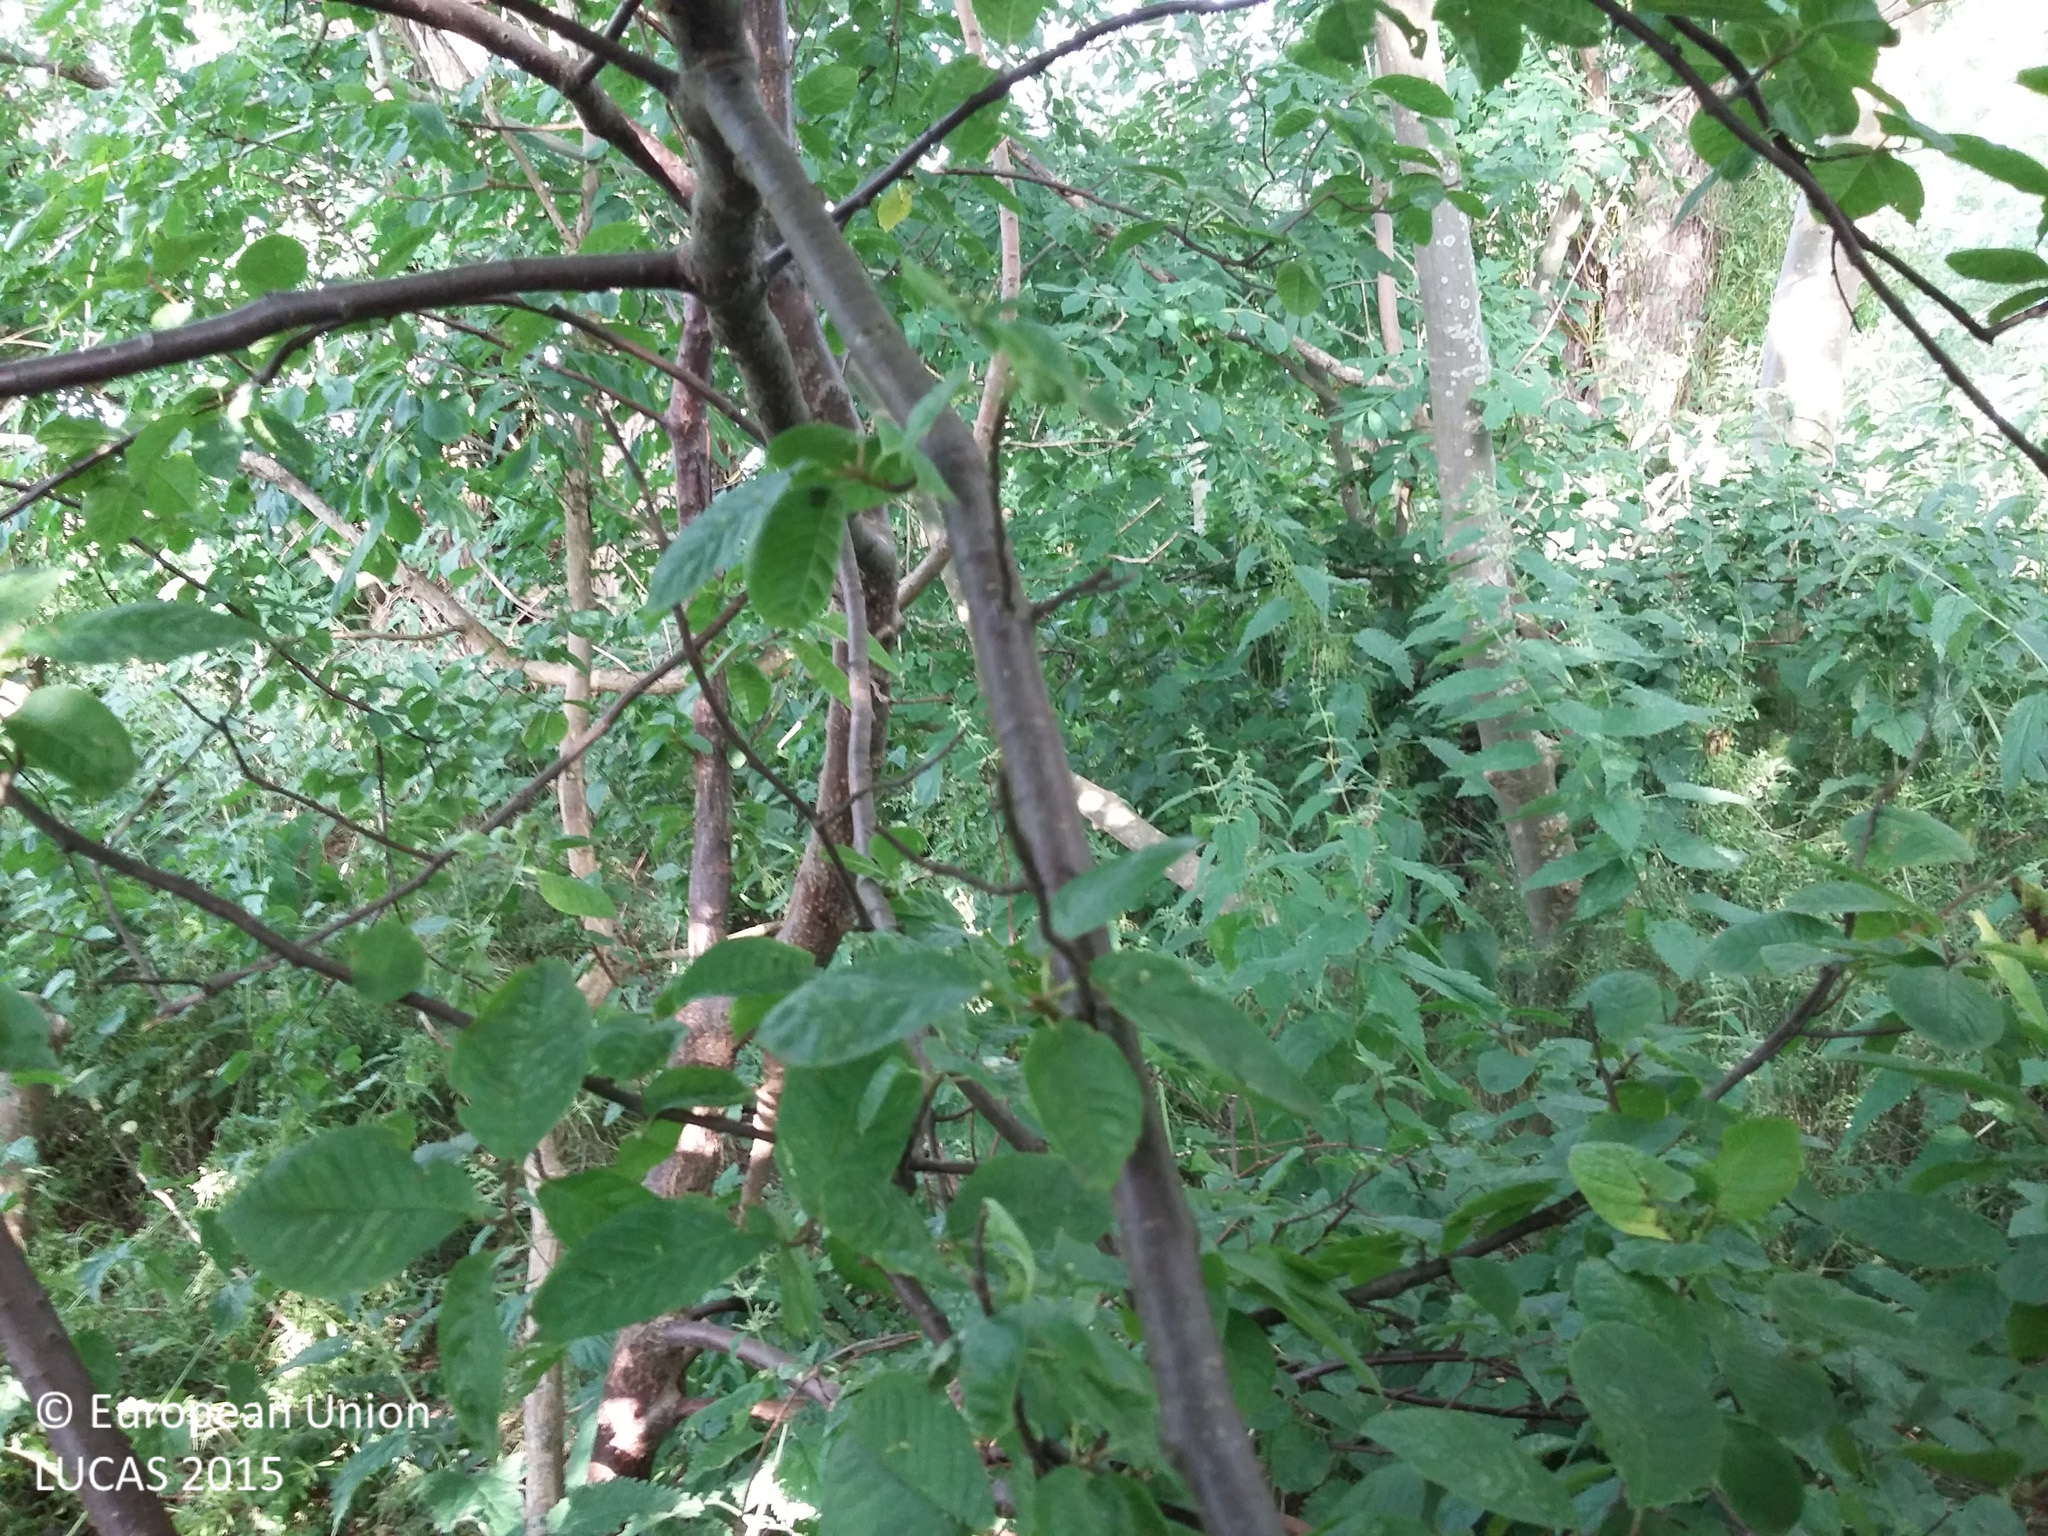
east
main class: Woodland
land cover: Broadleaved woodland
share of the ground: > 75 %
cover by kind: broadleaved forest trees 70 %, herbaceous plants 30 %
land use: Semi-natural and natural areas not in use
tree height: > 5 m
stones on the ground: < 10 %
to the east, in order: Broadleaved woodland; Tracks; Common wheat
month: July
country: DK
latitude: 55.8132
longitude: 11.9610
